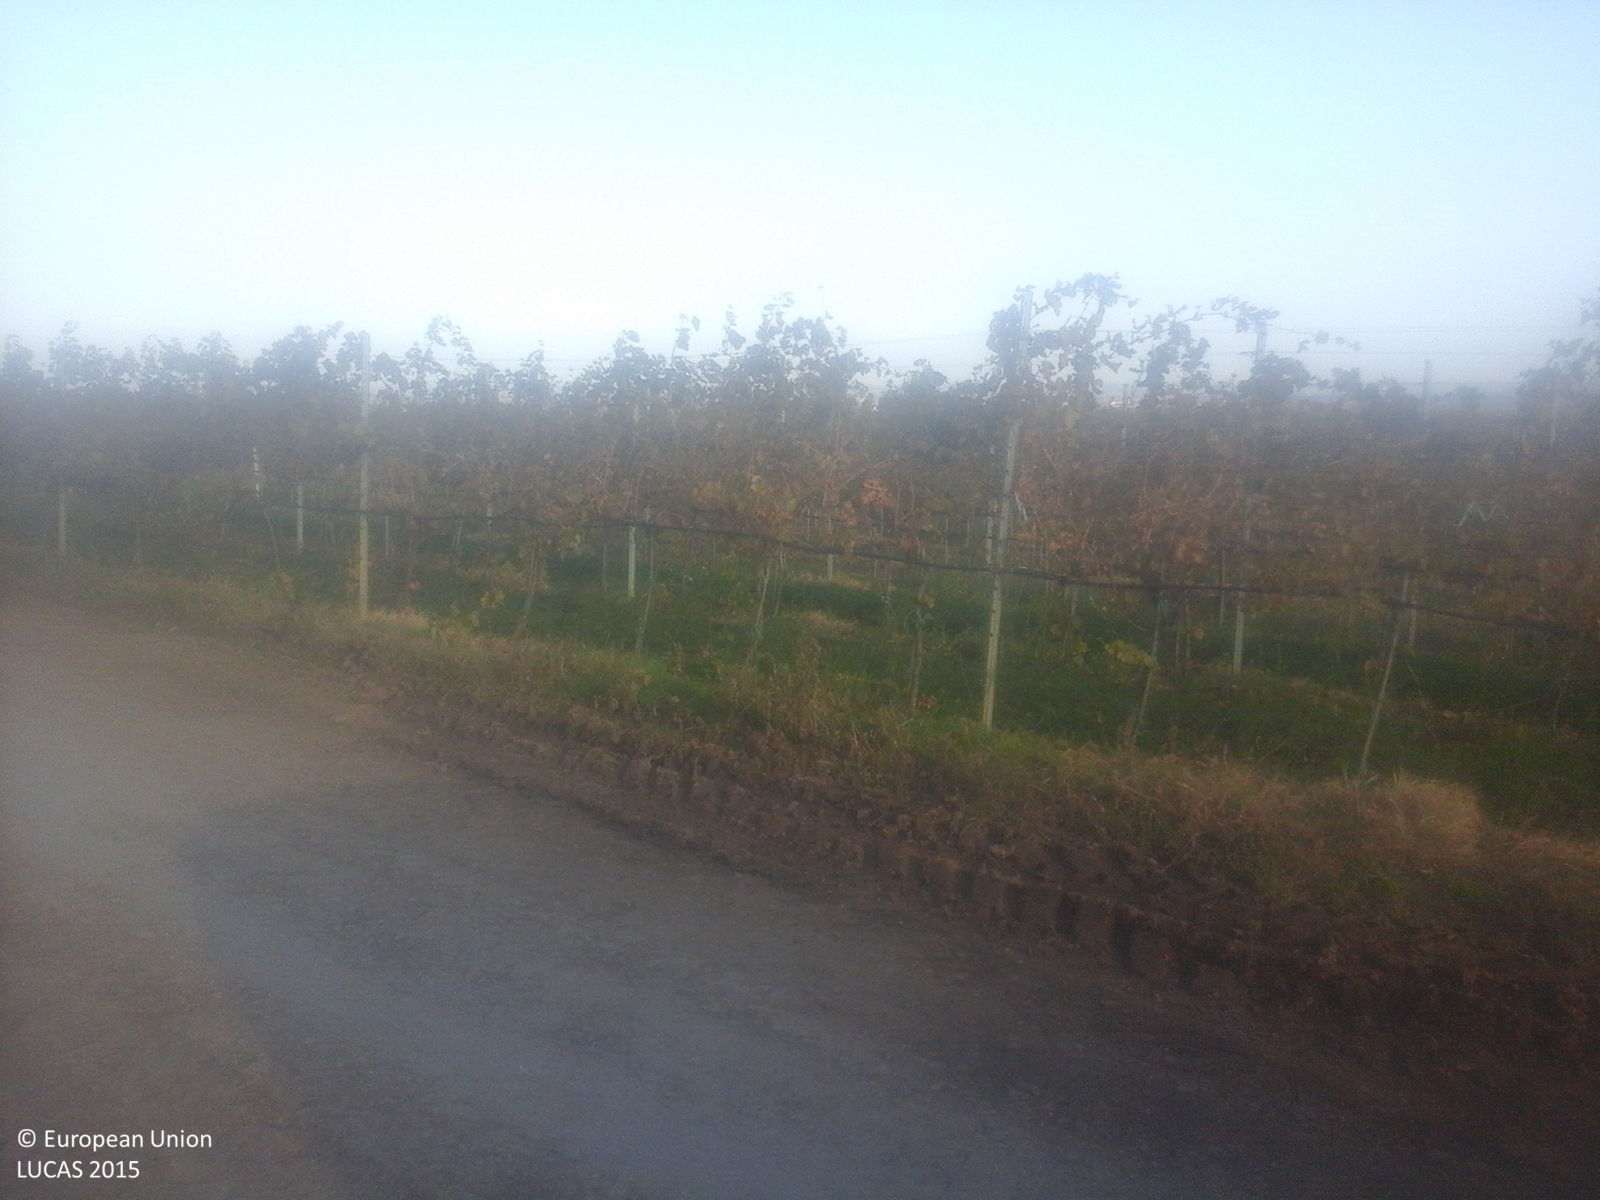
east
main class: Cropland
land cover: Vineyards
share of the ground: > 75 %
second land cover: Other bare soil
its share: > 75 %
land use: Agriculture (excluding fallow land and kitchen gardens)
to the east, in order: Vineyards; Other bare soil; Tracks; Vineyards; Tracks; Vineyards
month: October
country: RO
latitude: 45.3849
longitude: 26.9833
